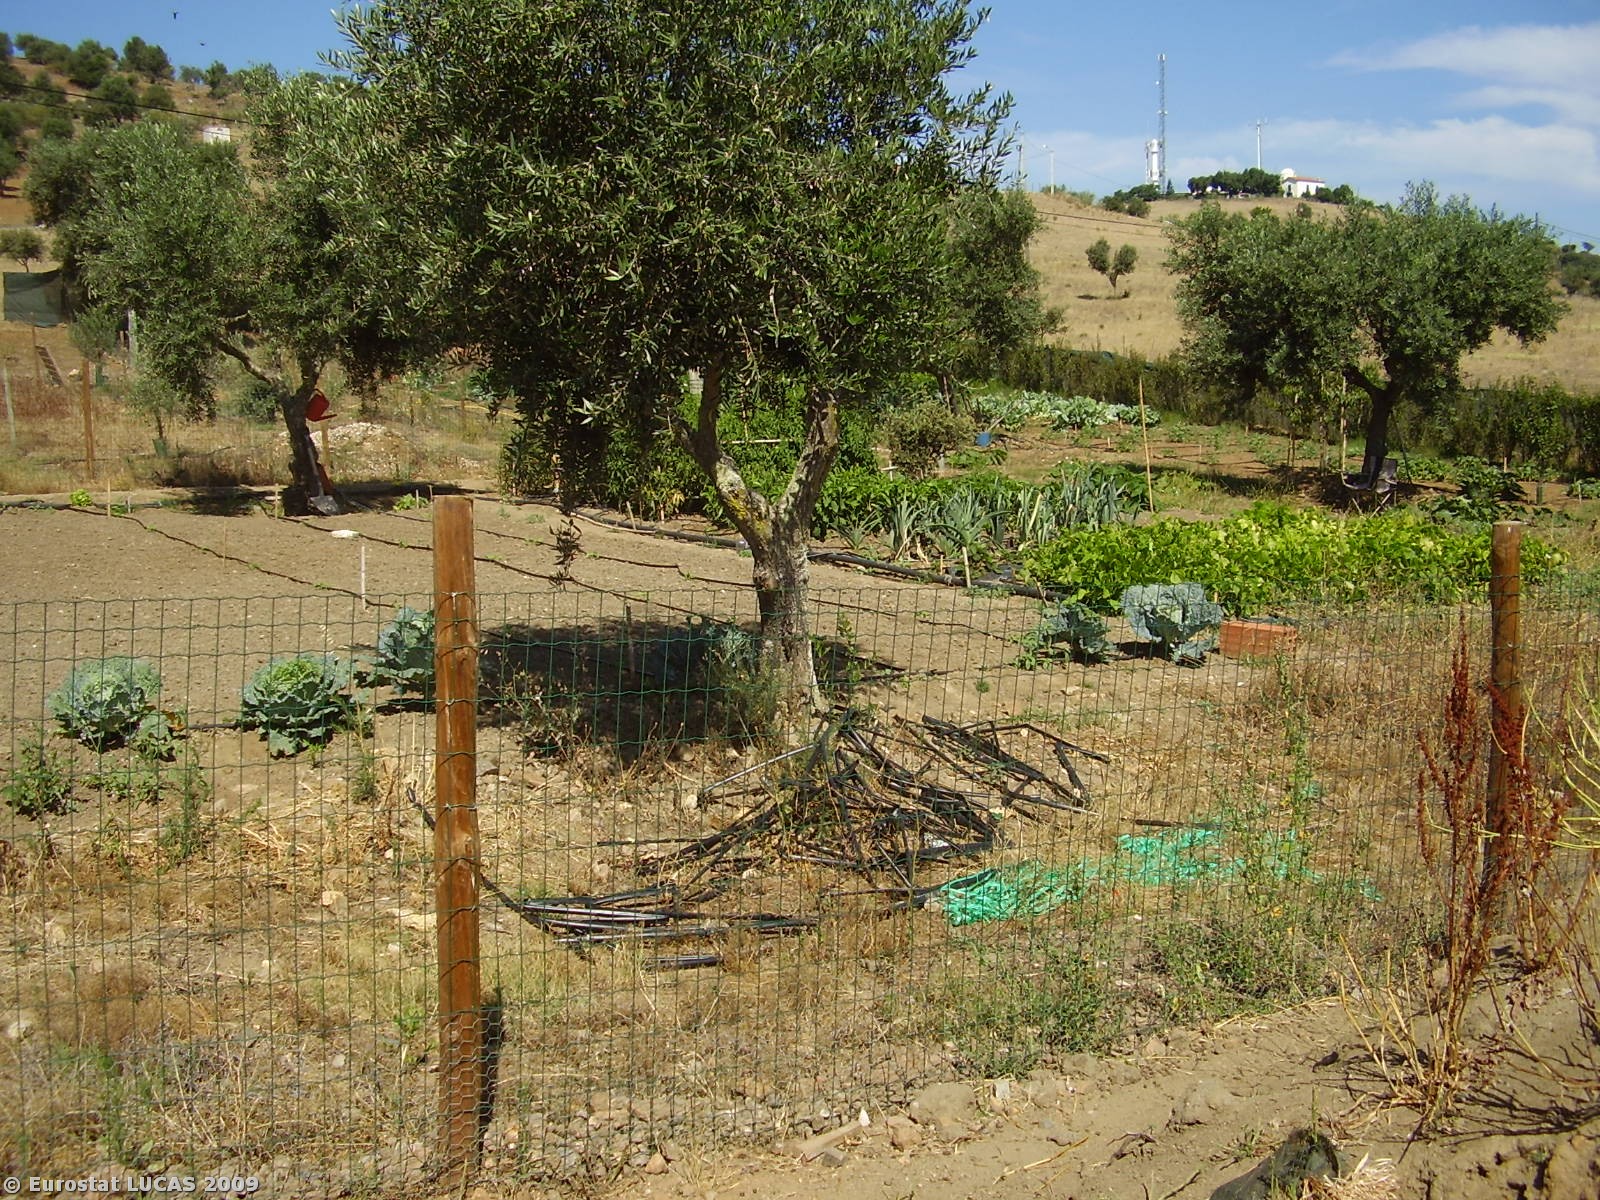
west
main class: Woodland
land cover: Broadleaved woodland
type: broadleaved evergreen forest
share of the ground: 10 - 25 %
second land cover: Grassland with sparse tree/shrub cover
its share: 50 - 75 %
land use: Forestry
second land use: Fallow land
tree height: > 5 m
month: July
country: PT
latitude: 38.7211
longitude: -7.9751
